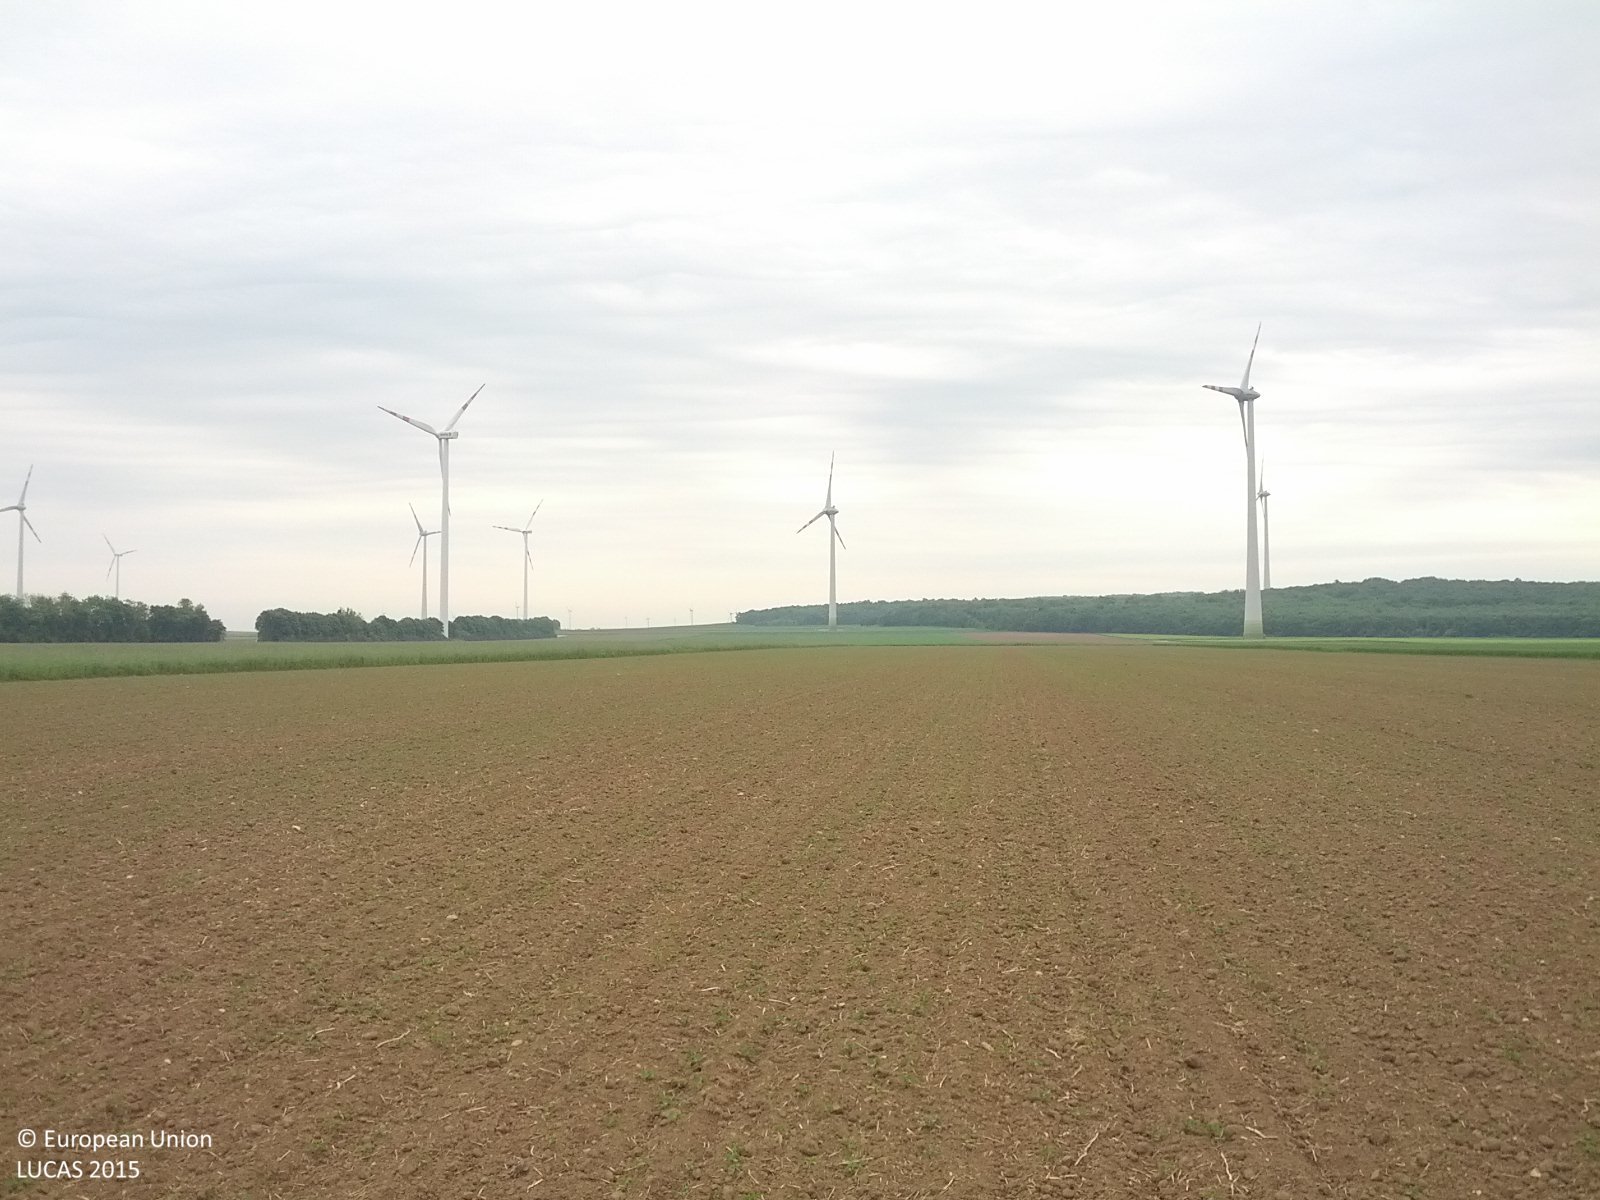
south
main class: Cropland
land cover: Soya
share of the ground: < 10 %
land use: Agriculture (excluding fallow land and kitchen gardens)
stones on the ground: < 10 %
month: May
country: AT
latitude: 48.1062
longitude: 16.7616
